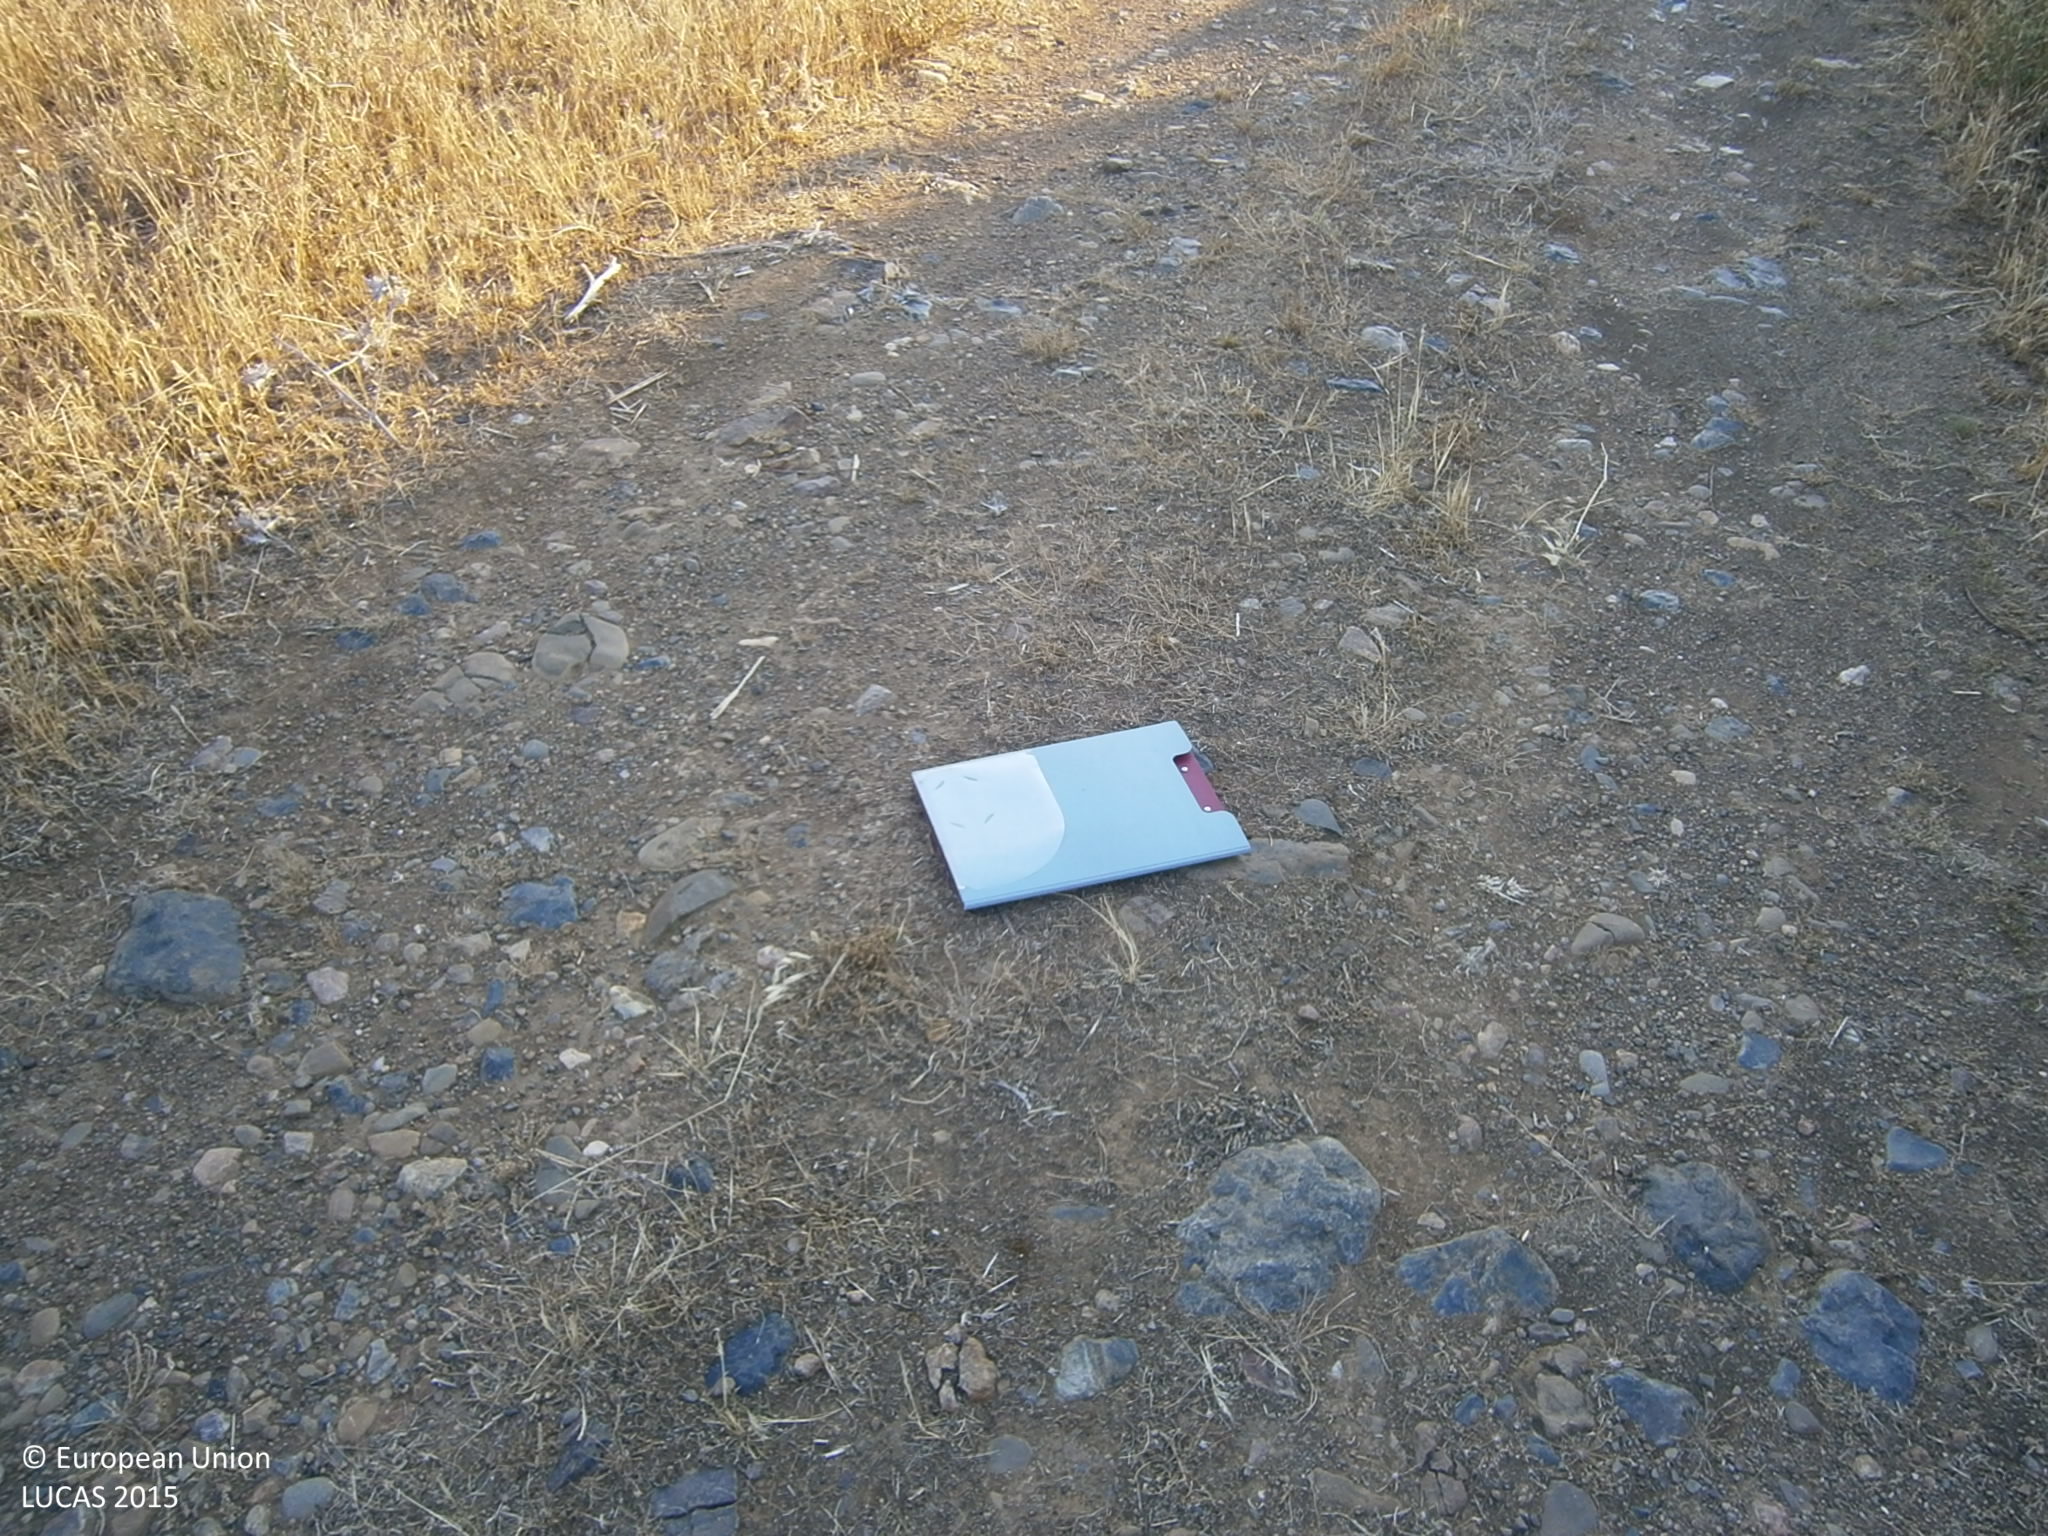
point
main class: Grassland
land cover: Spontaneously vegetated surfaces
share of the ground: > 75 %
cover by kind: herbaceous plants 95 %, unconsolidated bare surface 5 %
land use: Abandoned areas
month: June
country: ES
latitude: 38.6447
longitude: -6.7786
